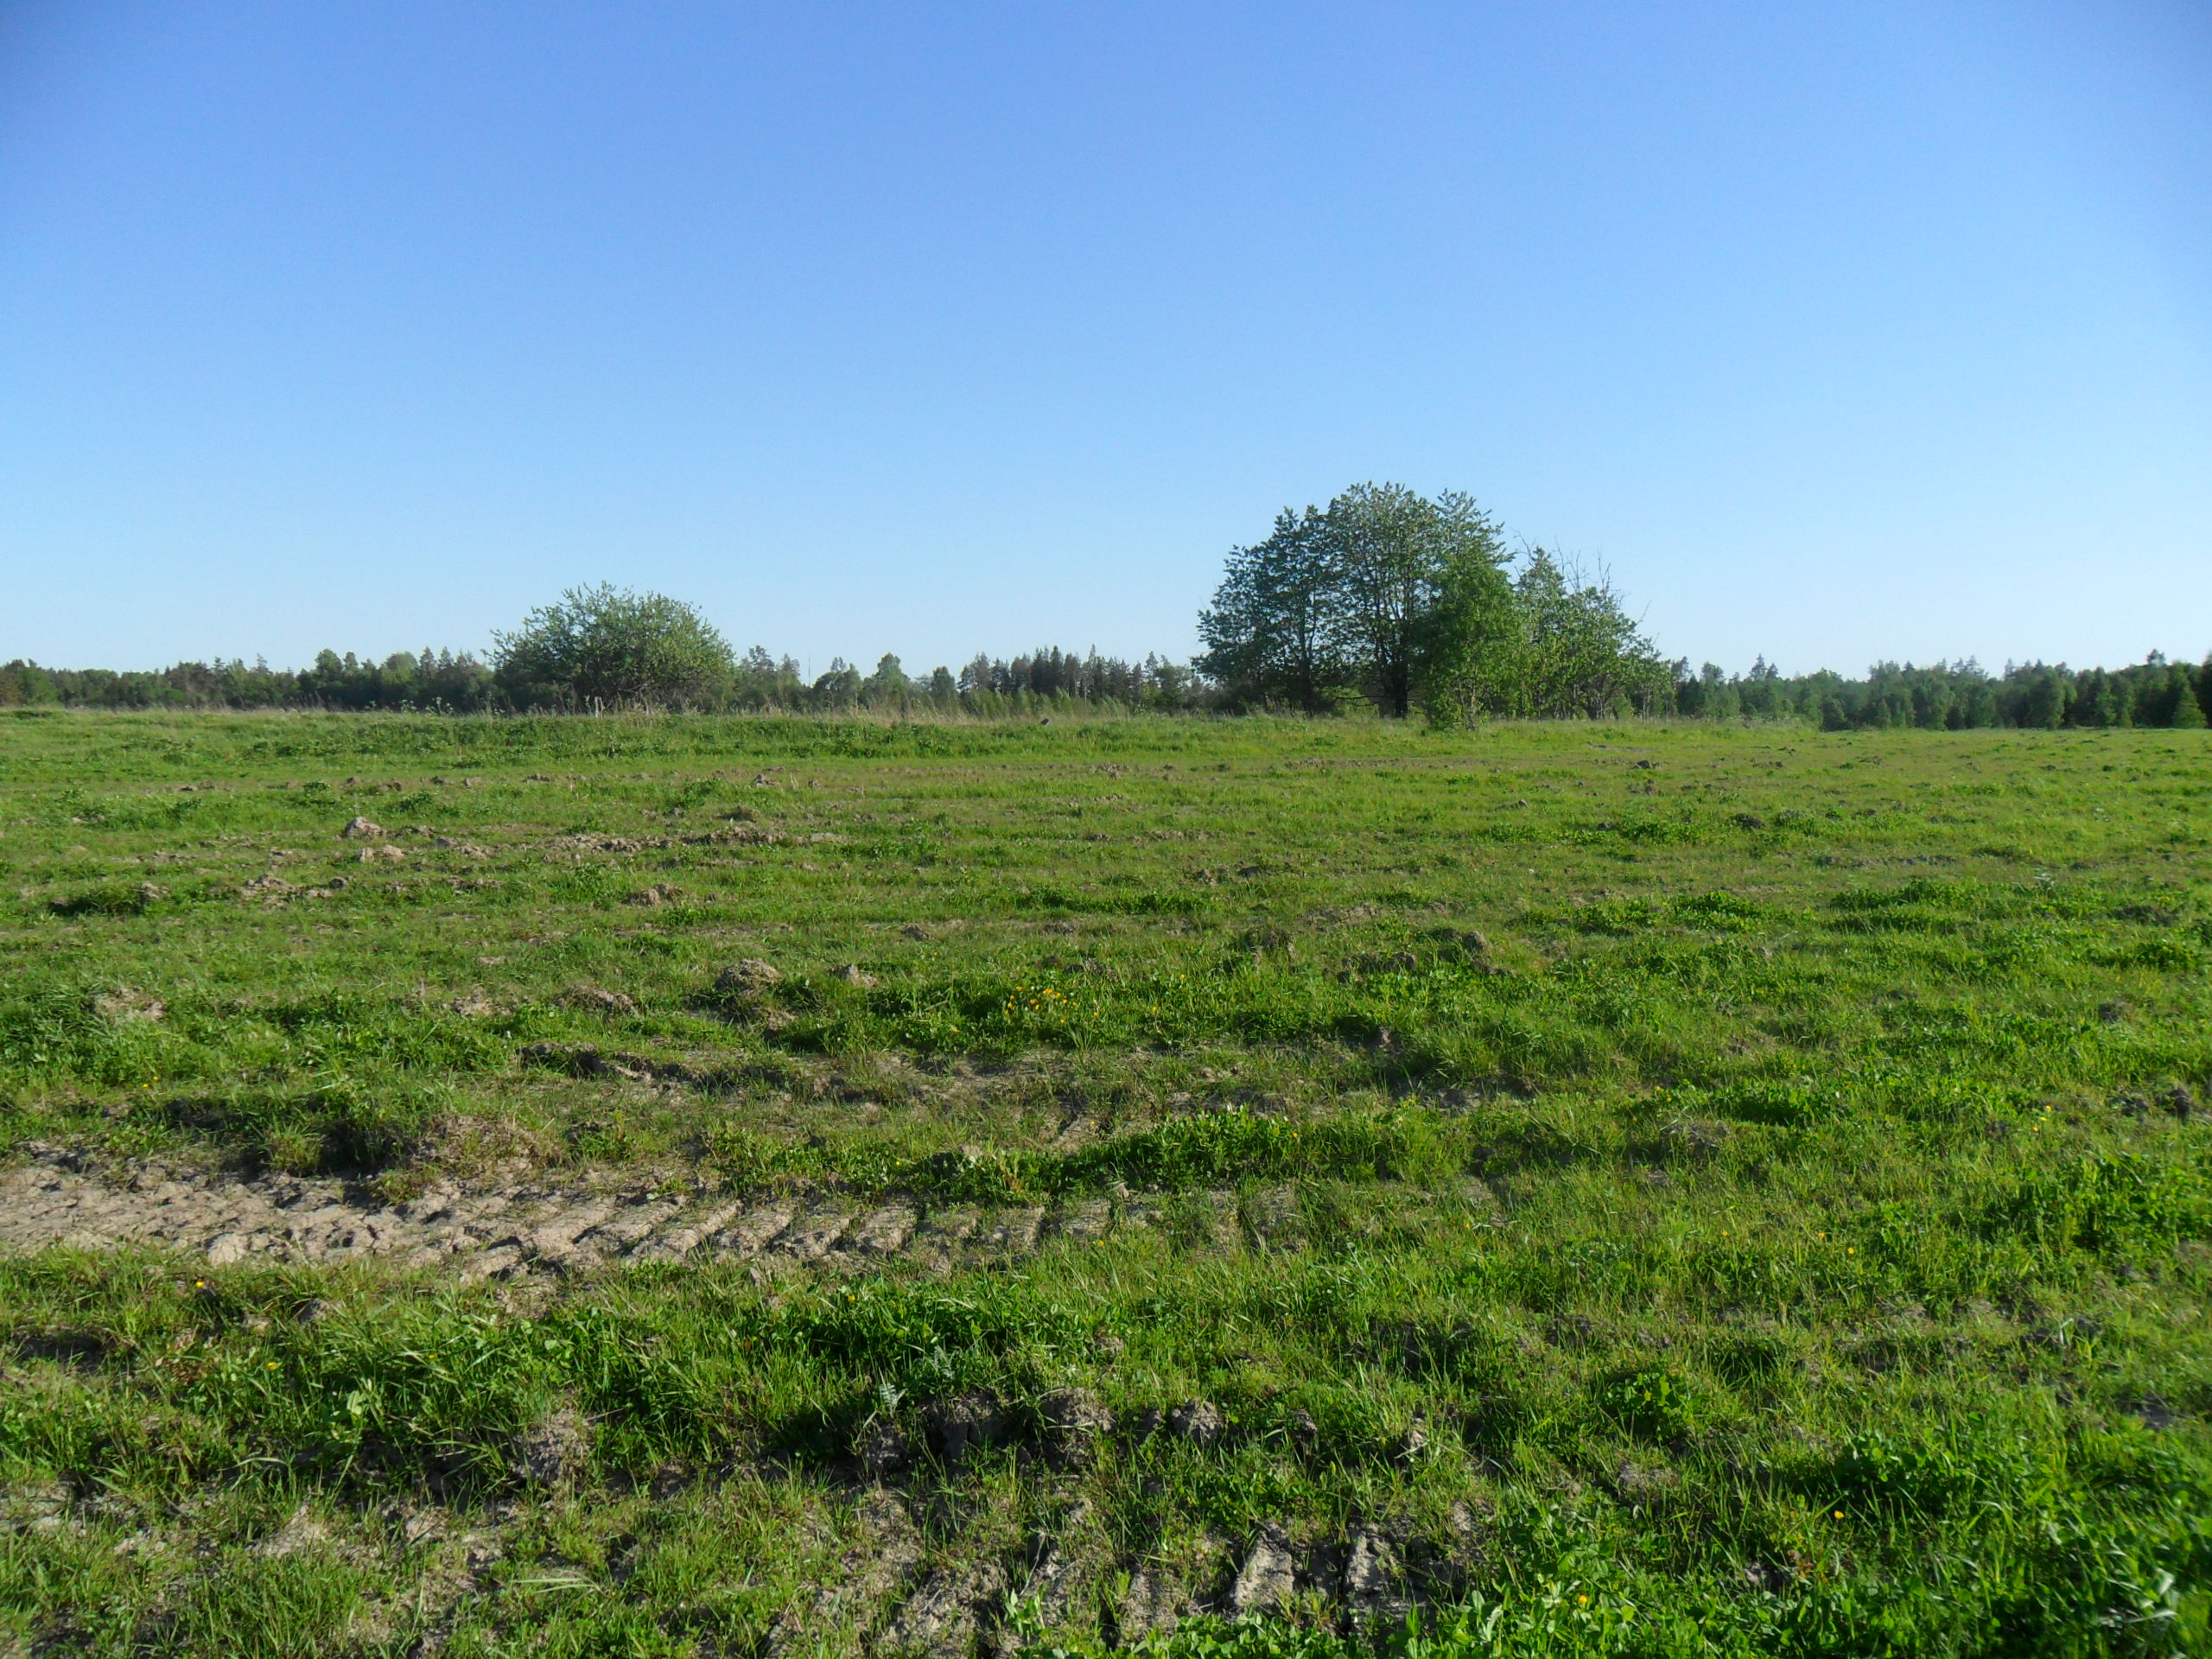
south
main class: Grassland
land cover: Grassland without tree/shrub cover
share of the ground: > 75 %
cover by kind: herbaceous plants 85 %, unconsolidated bare surface 5 %
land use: Agriculture (excluding fallow land and kitchen gardens)
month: June
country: LV
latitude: 57.5752
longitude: 22.3402
